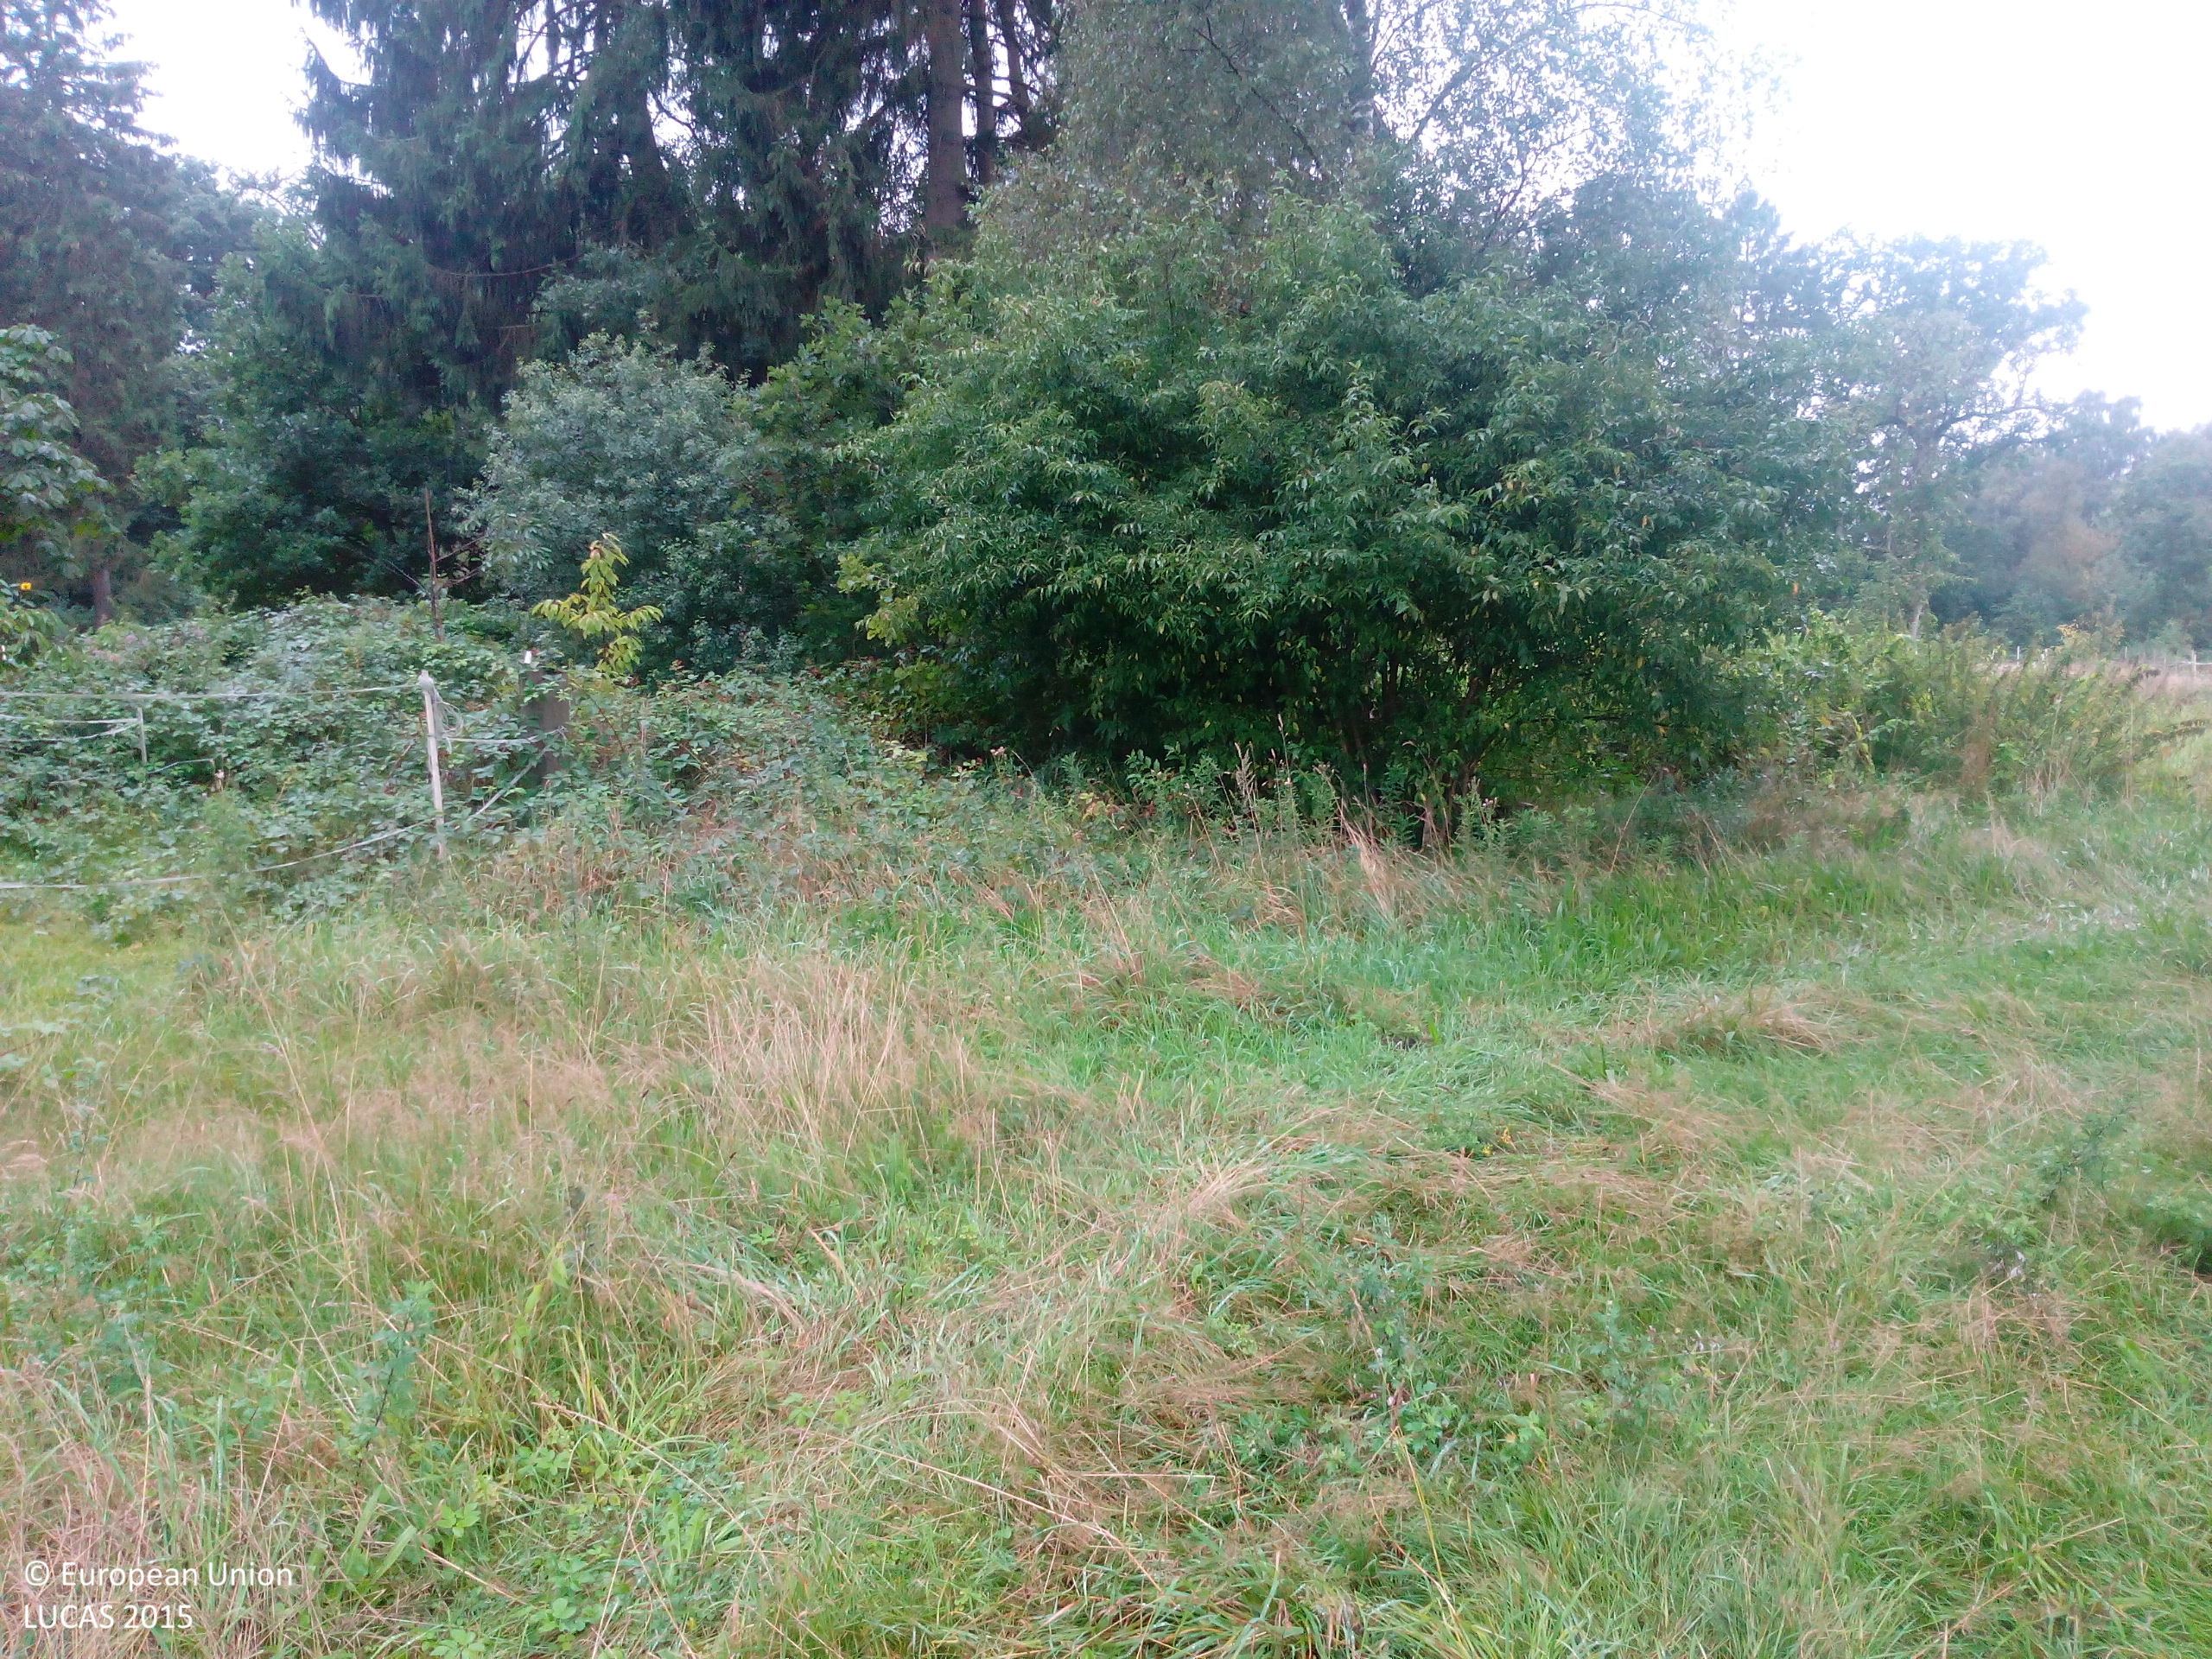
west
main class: Grassland
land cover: Grassland without tree/shrub cover
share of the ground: > 75 %
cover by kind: herbaceous plants 100 %
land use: Agriculture (excluding fallow land and kitchen gardens)
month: August
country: DE
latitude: 53.7254
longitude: 9.9546
